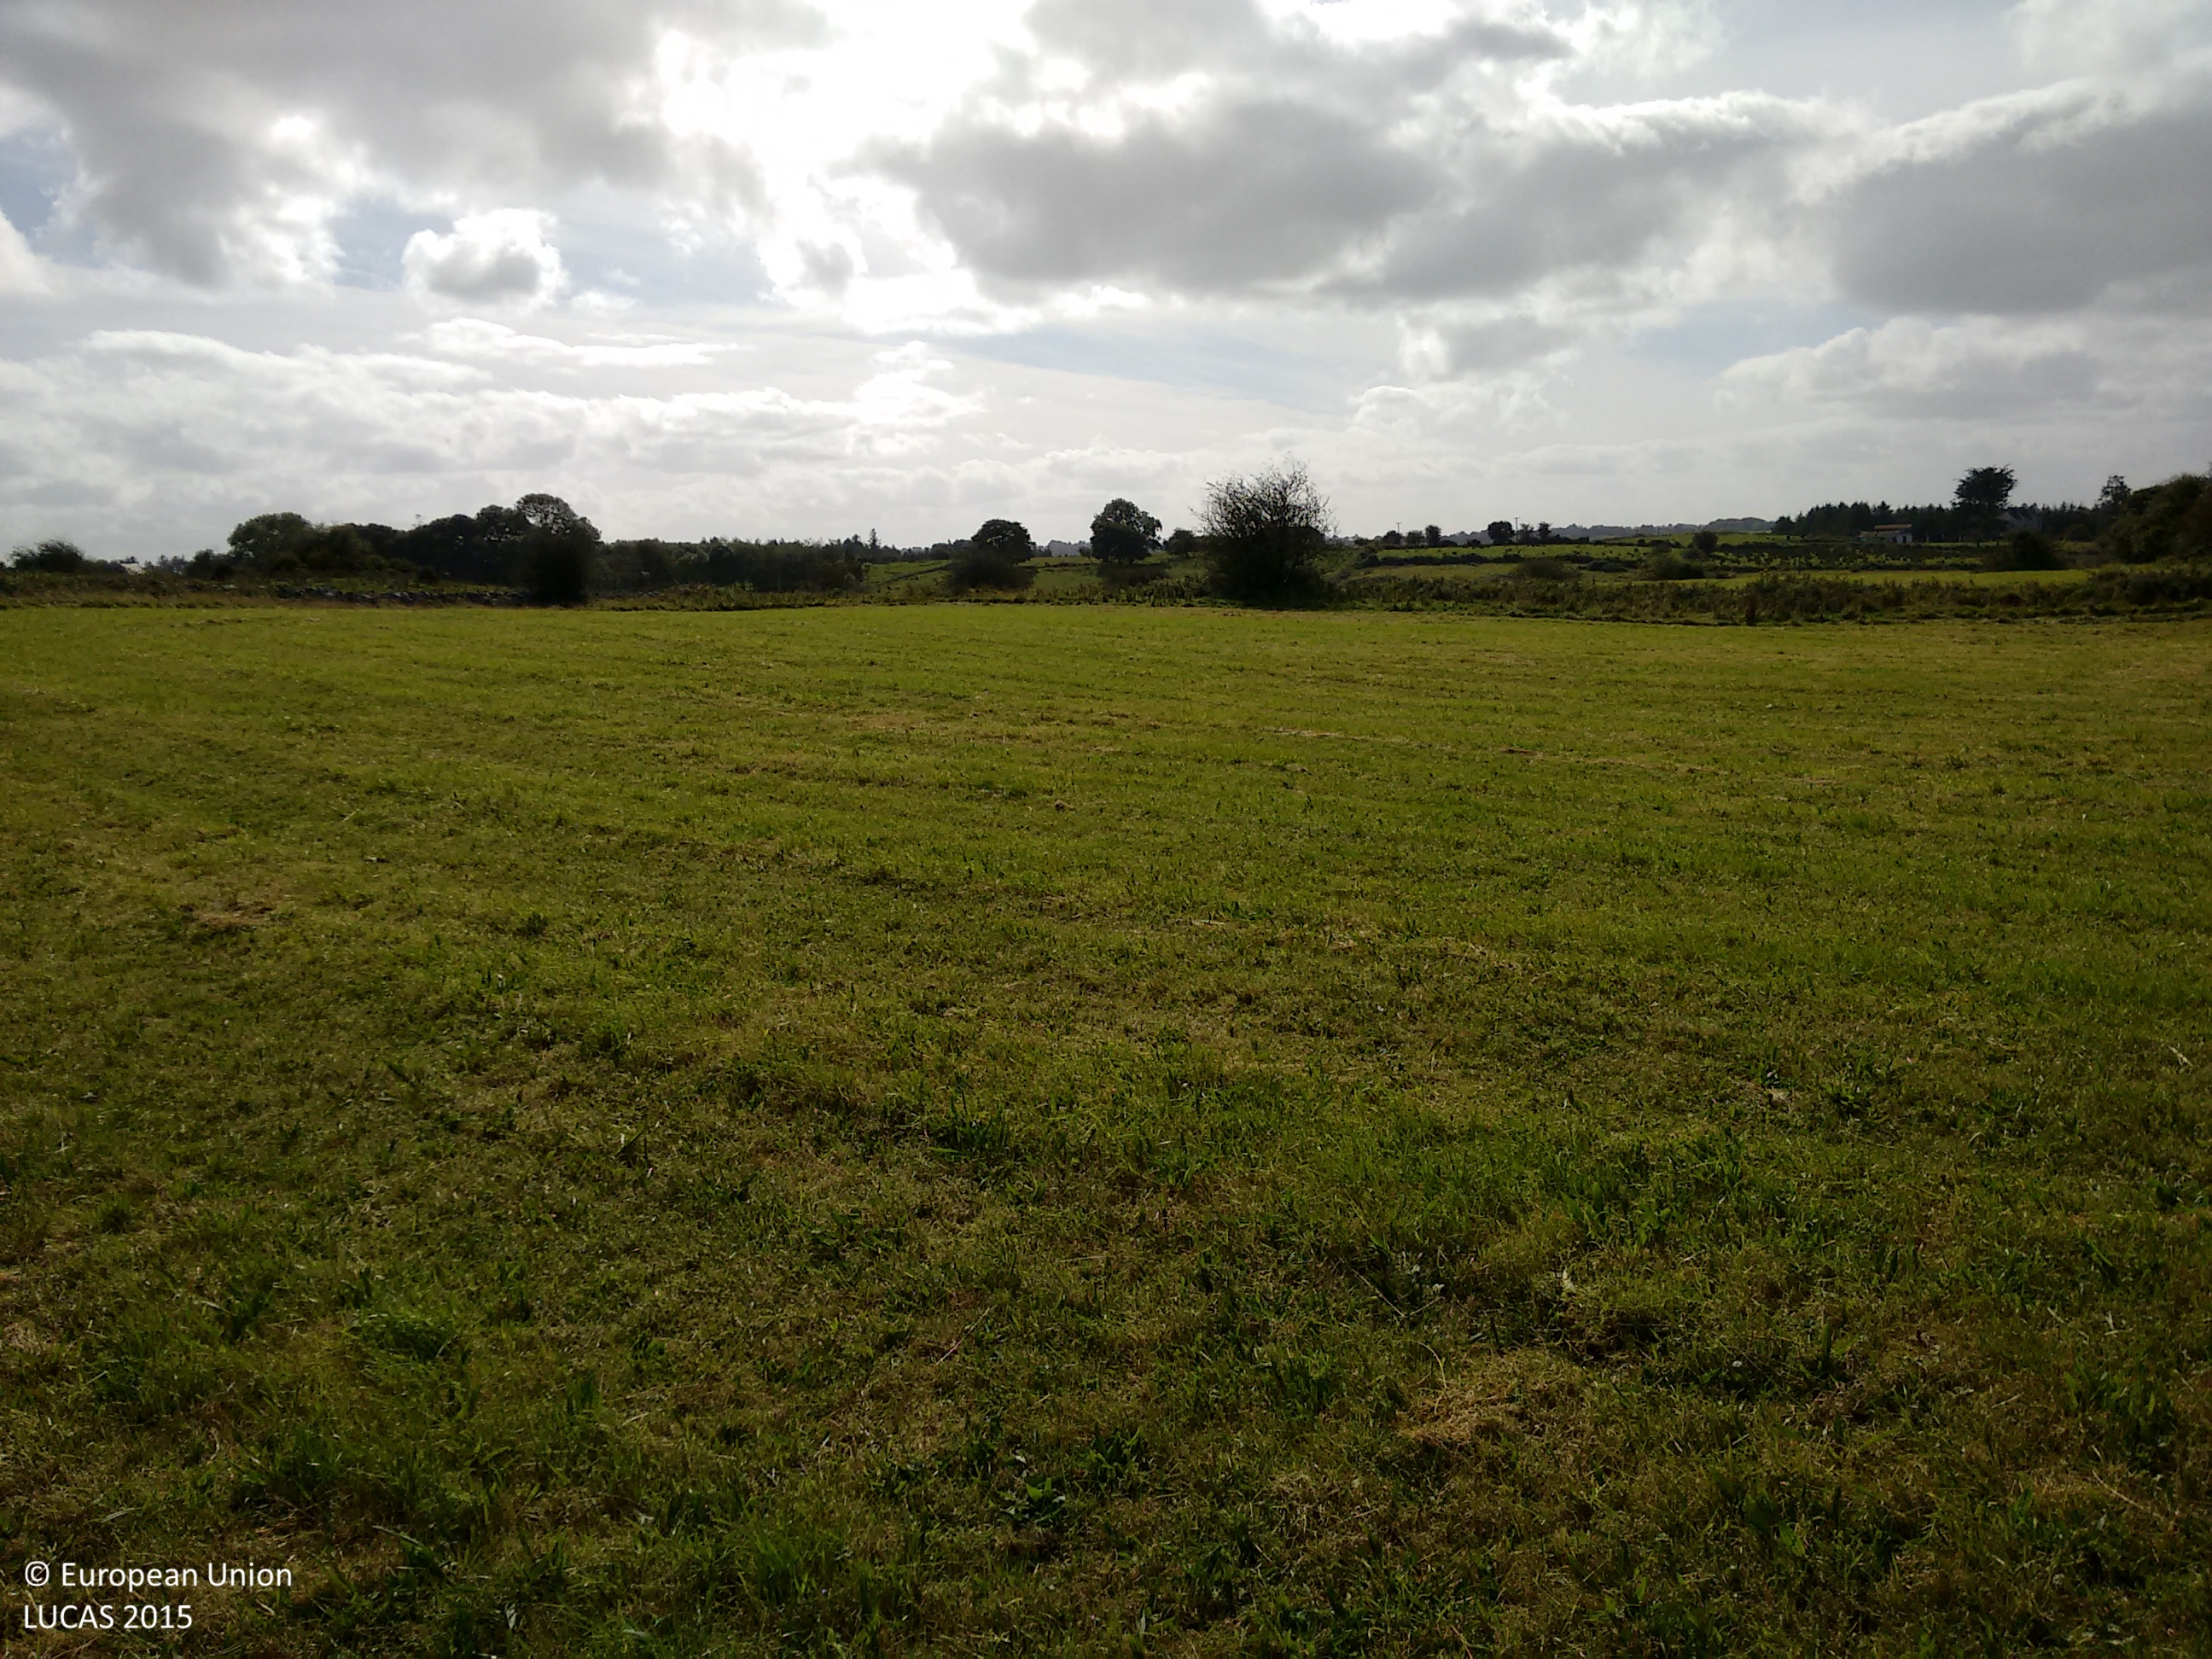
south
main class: Grassland
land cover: Grassland without tree/shrub cover
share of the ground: > 75 %
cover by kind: herbaceous plants 100 %
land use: Agriculture (excluding fallow land and kitchen gardens)
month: September
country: IE
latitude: 53.8134
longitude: -8.8095
